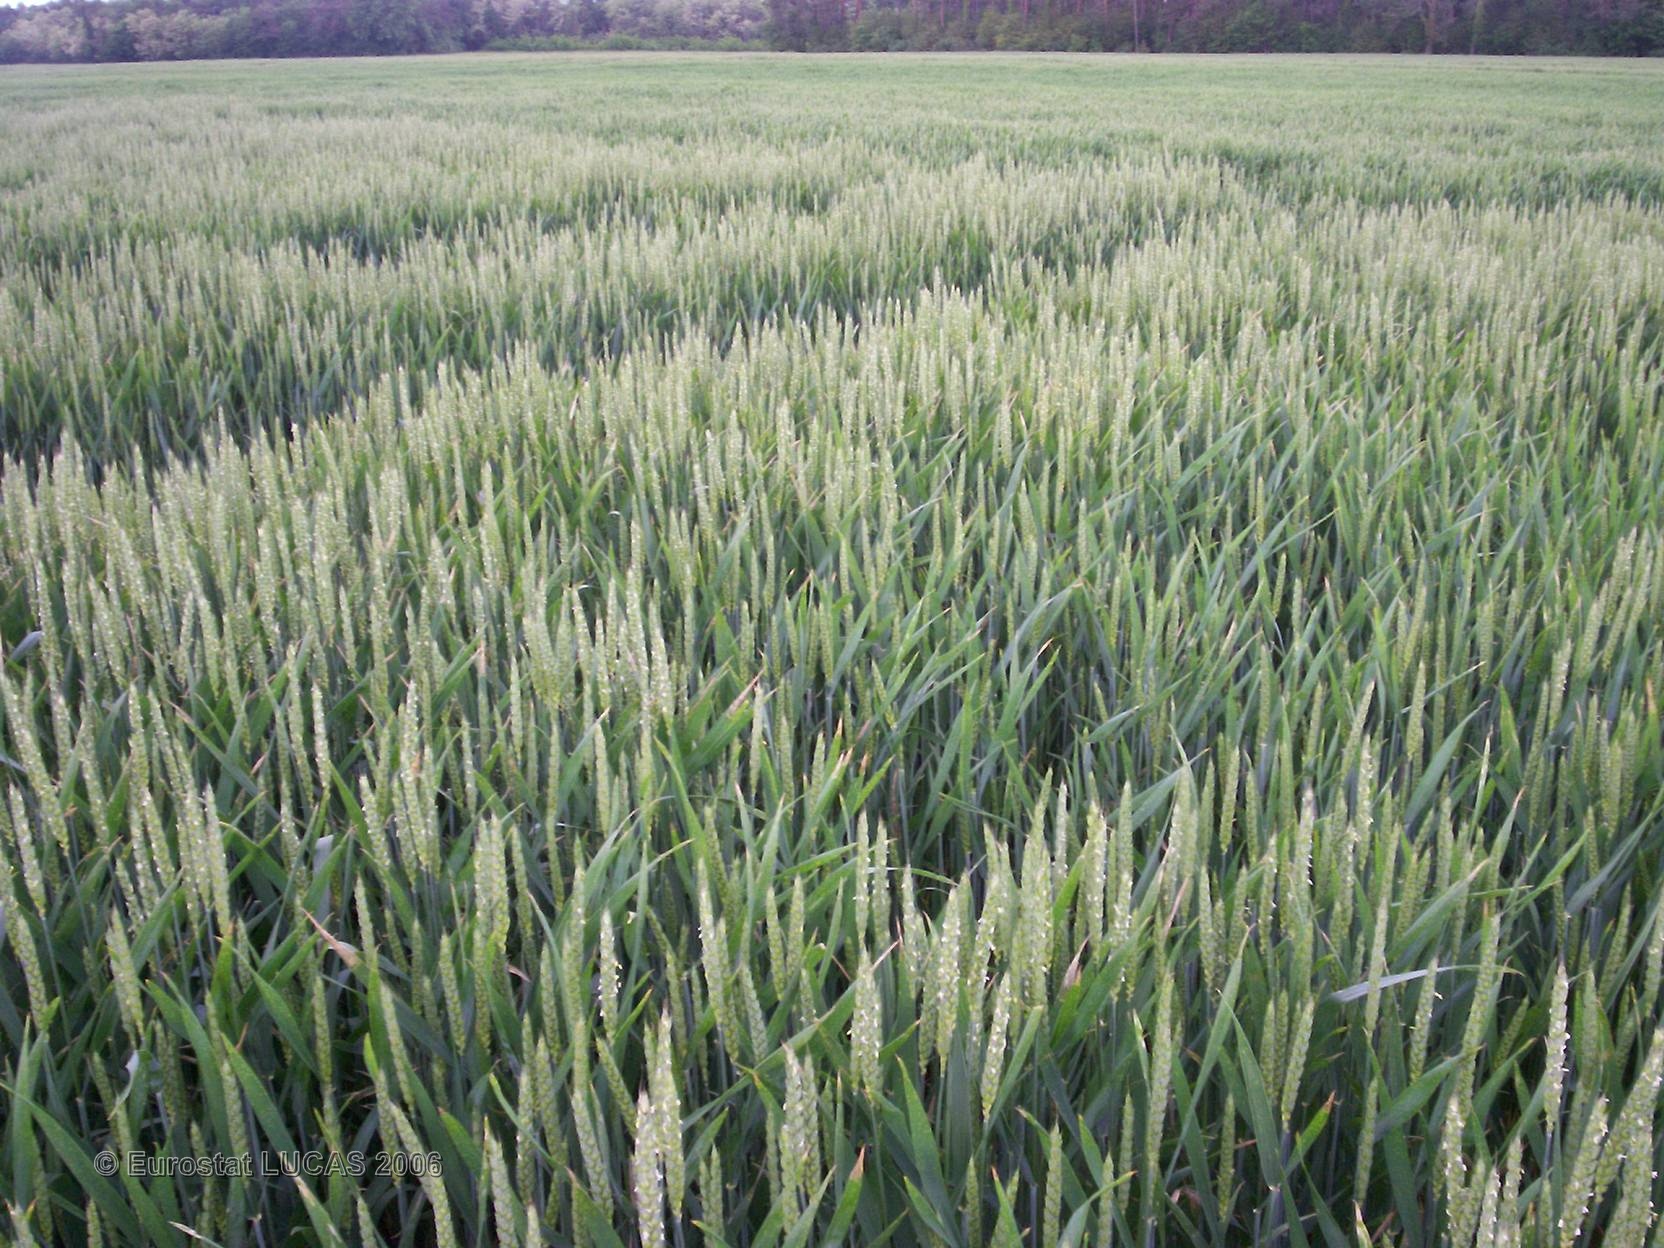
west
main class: Cropland
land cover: Common wheat
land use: Agriculture (excluding fallow land and kitchen gardens)
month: May
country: FR
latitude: 46.8380
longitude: 0.3428
